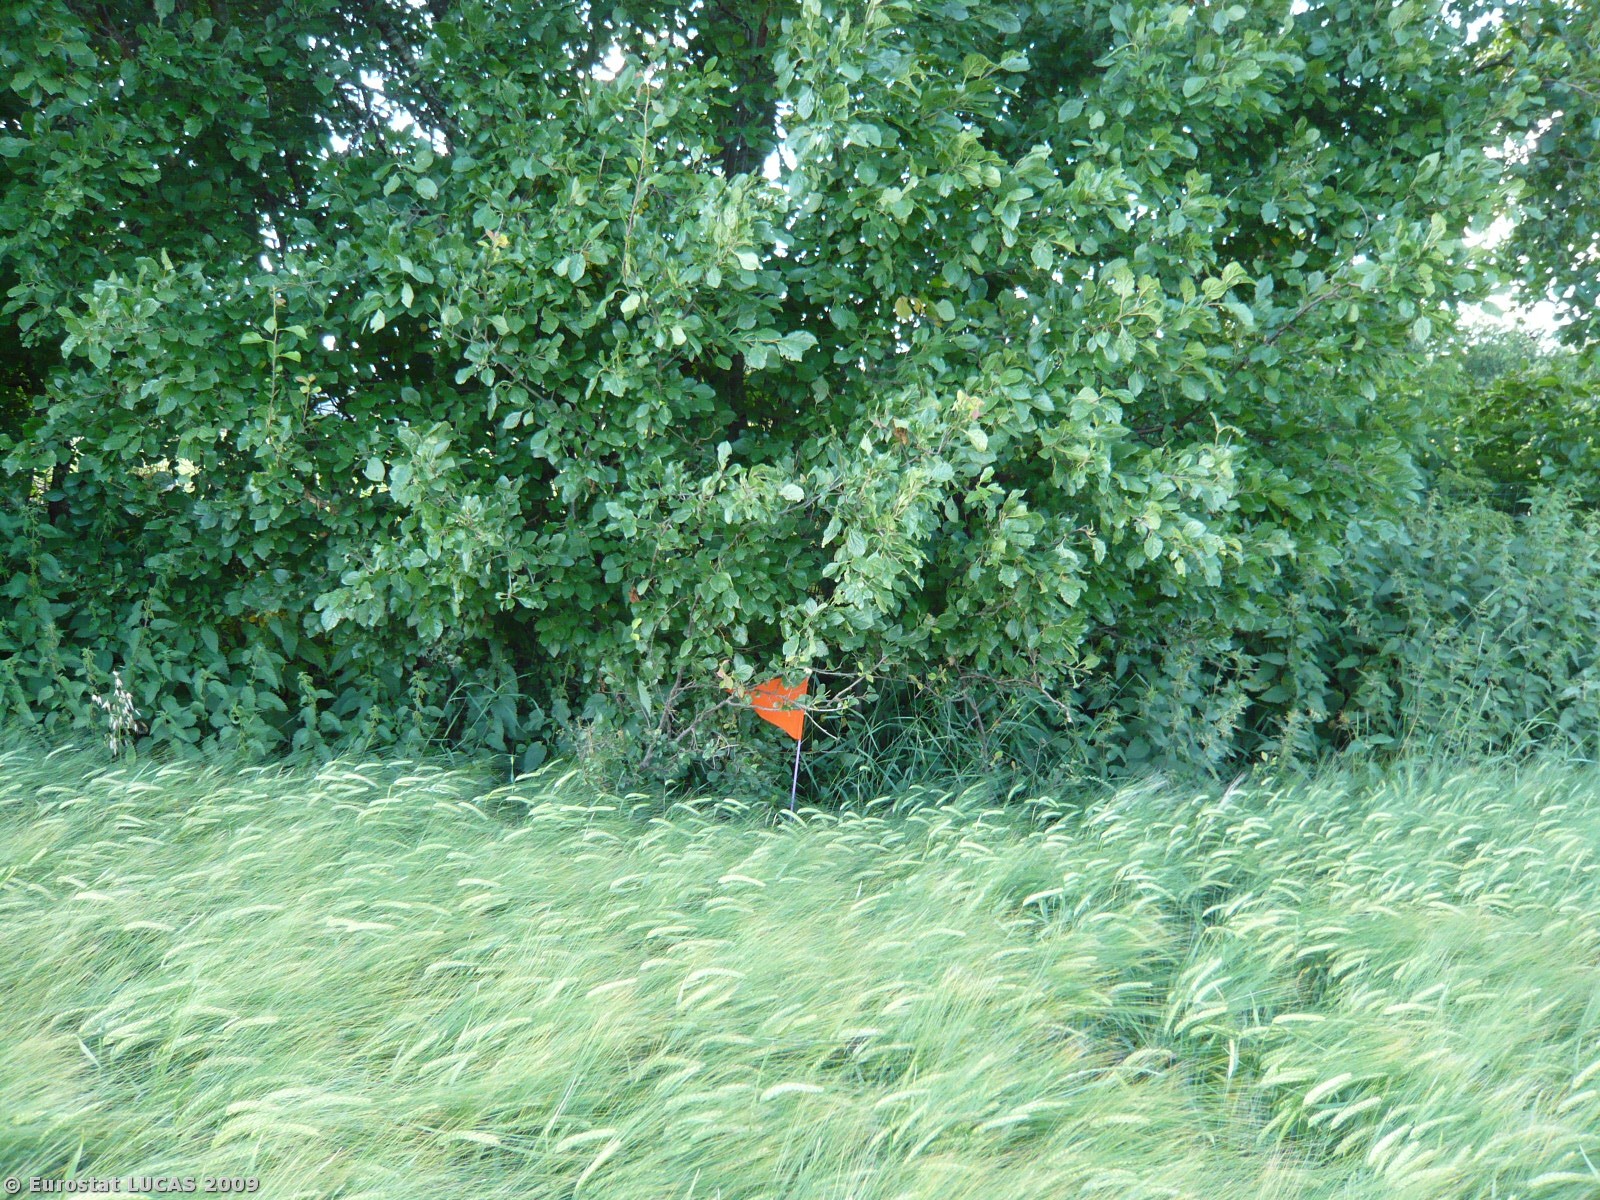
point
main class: Woodland
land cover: Broadleaved woodland
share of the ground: > 75 %
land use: Residential
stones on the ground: < 10 %
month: July
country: DK
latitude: 55.5691
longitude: 11.3784
